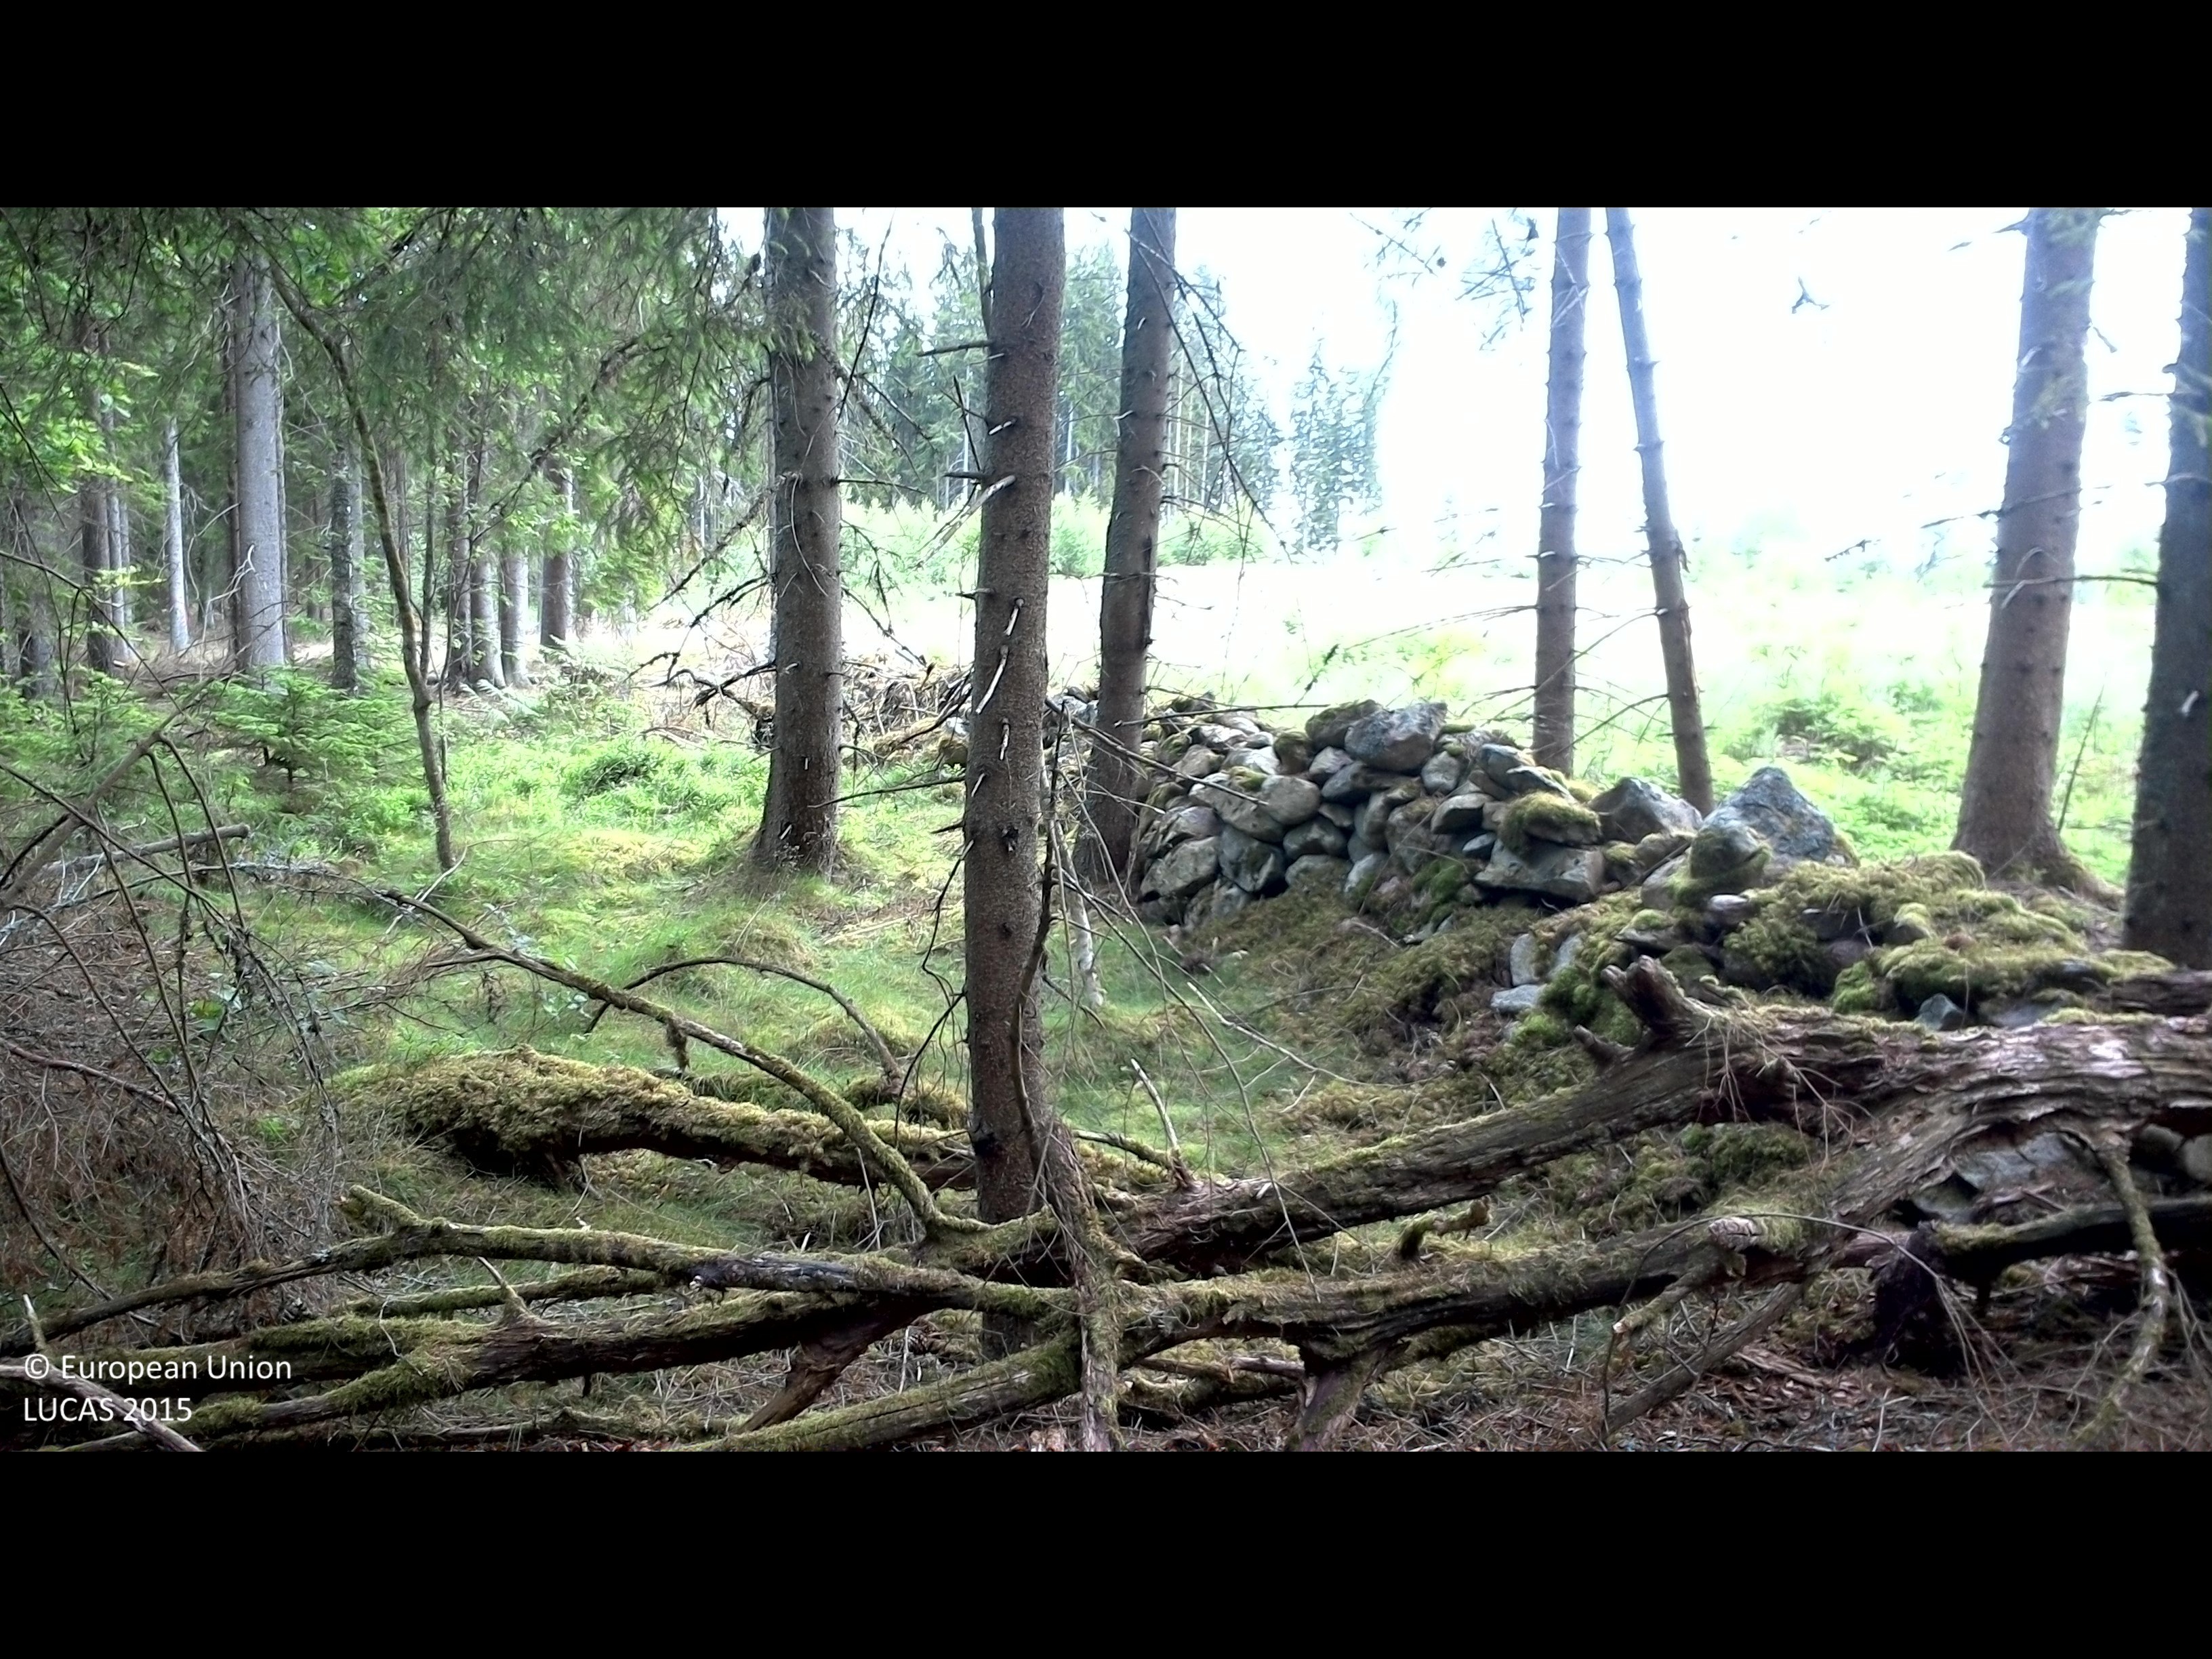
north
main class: Woodland
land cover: Spruce dominated coniferous woodland
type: boreal forest
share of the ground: 50 - 75 %
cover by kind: coniferous forest trees 70 %, lichens and mosses 25 %, herbaceous plants 5 %
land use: Forestry
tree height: > 5 m
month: July
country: SE
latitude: 56.5150
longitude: 14.7270
